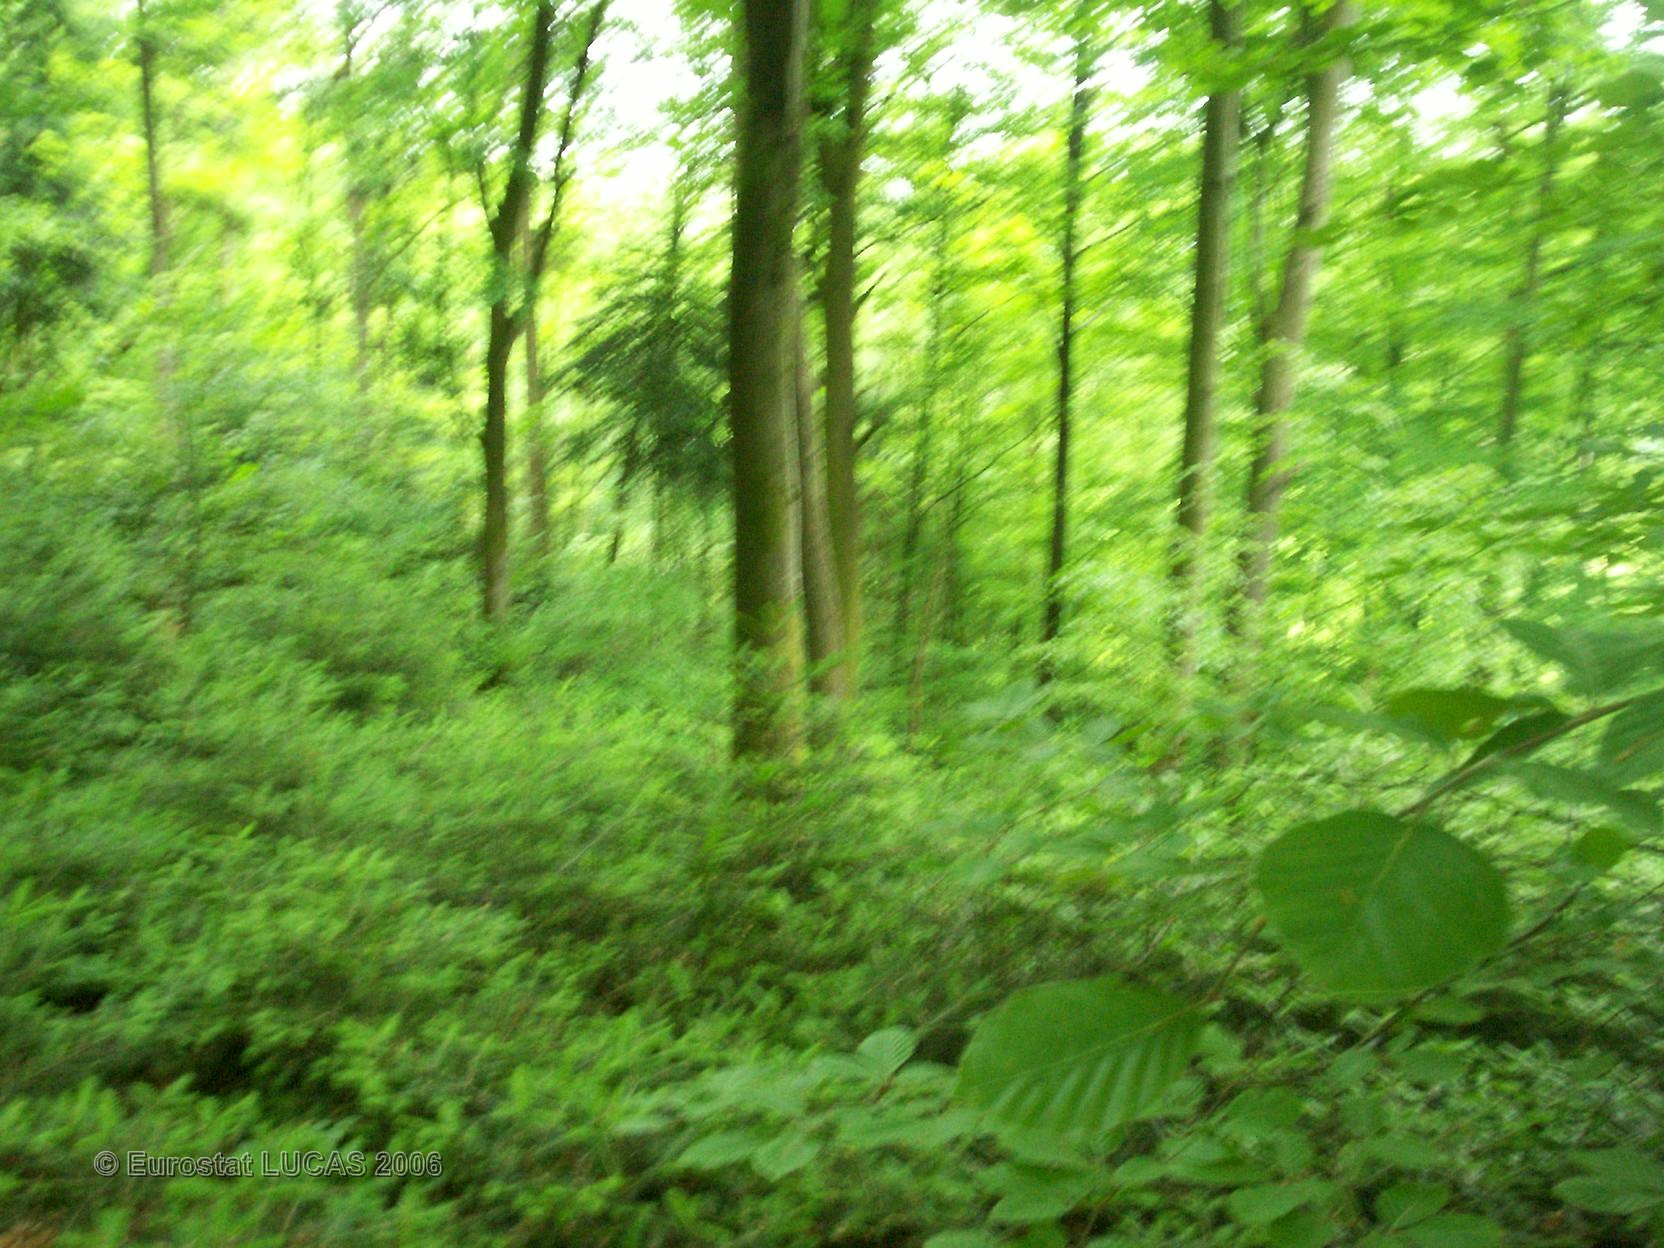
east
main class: Woodland
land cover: Mixed forest
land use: Forestry
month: May
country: FR
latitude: 48.1515
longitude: 6.5463
